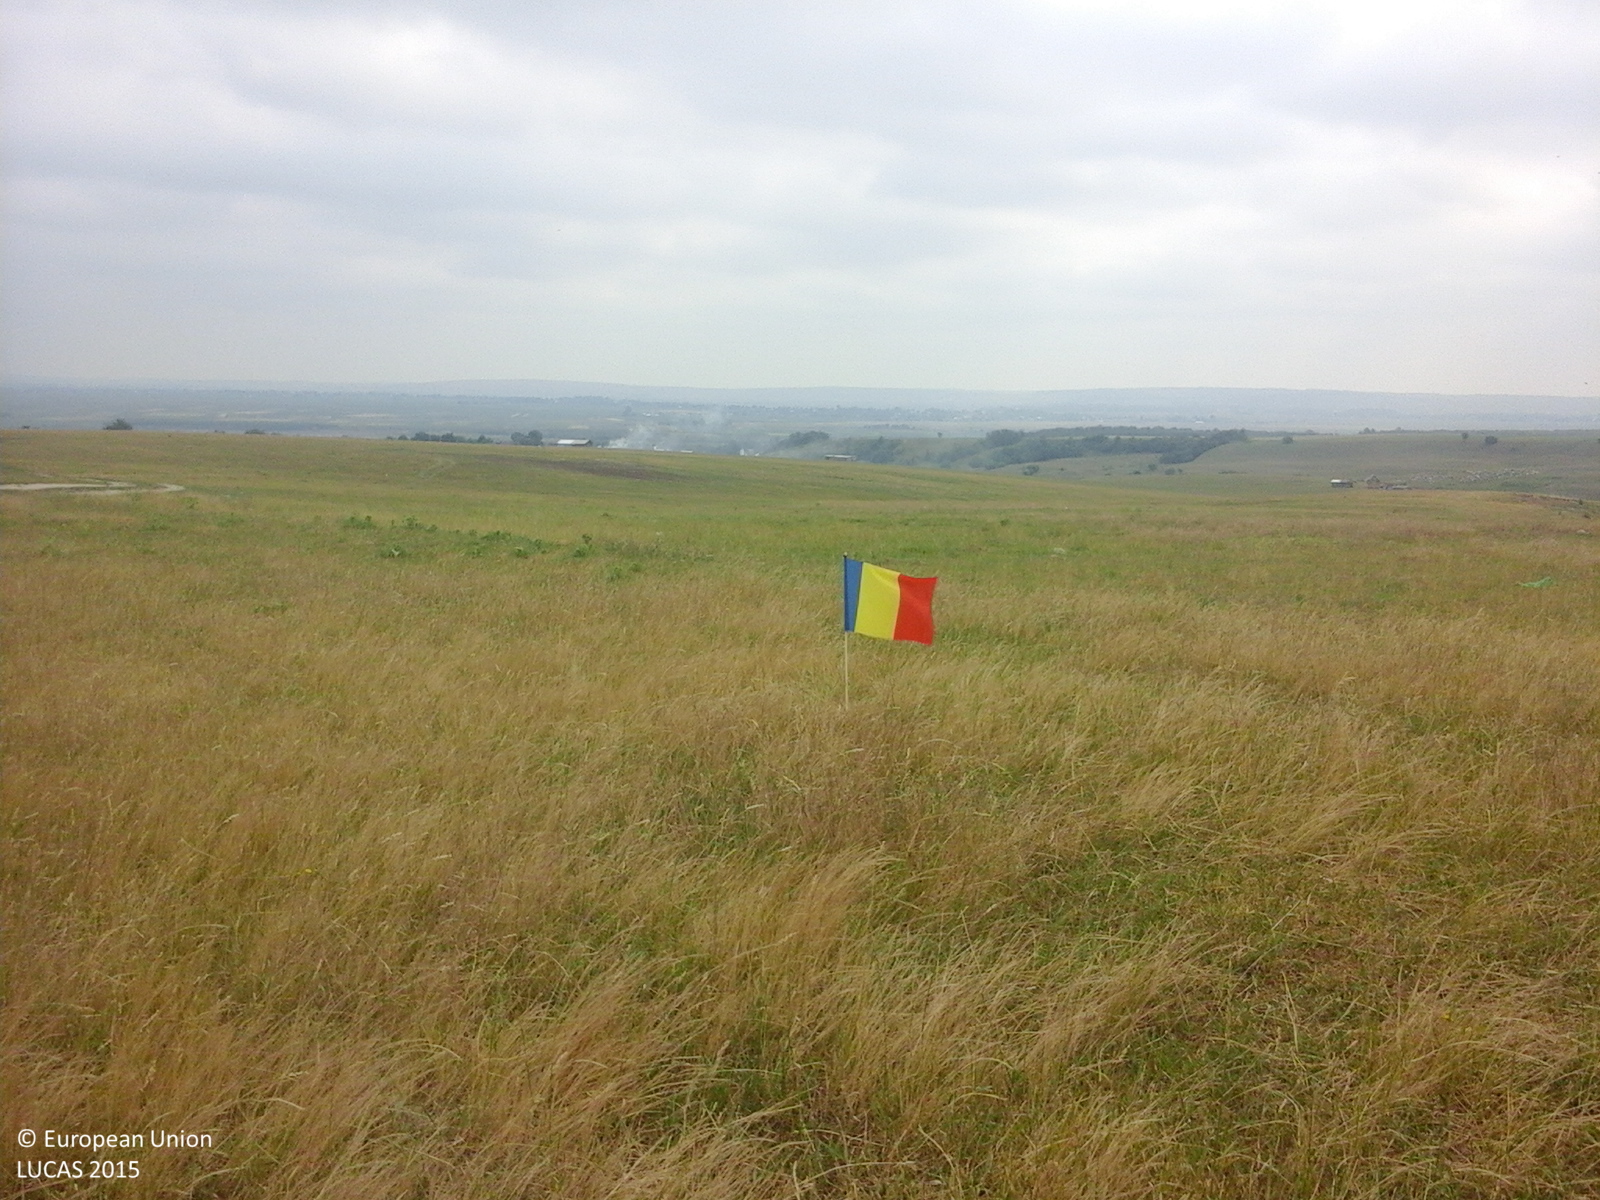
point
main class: Grassland
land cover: Grassland without tree/shrub cover
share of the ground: > 75 %
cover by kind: herbaceous plants 100 %
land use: Agriculture (excluding fallow land and kitchen gardens)
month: June
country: RO
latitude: 47.5427
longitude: 26.4699
